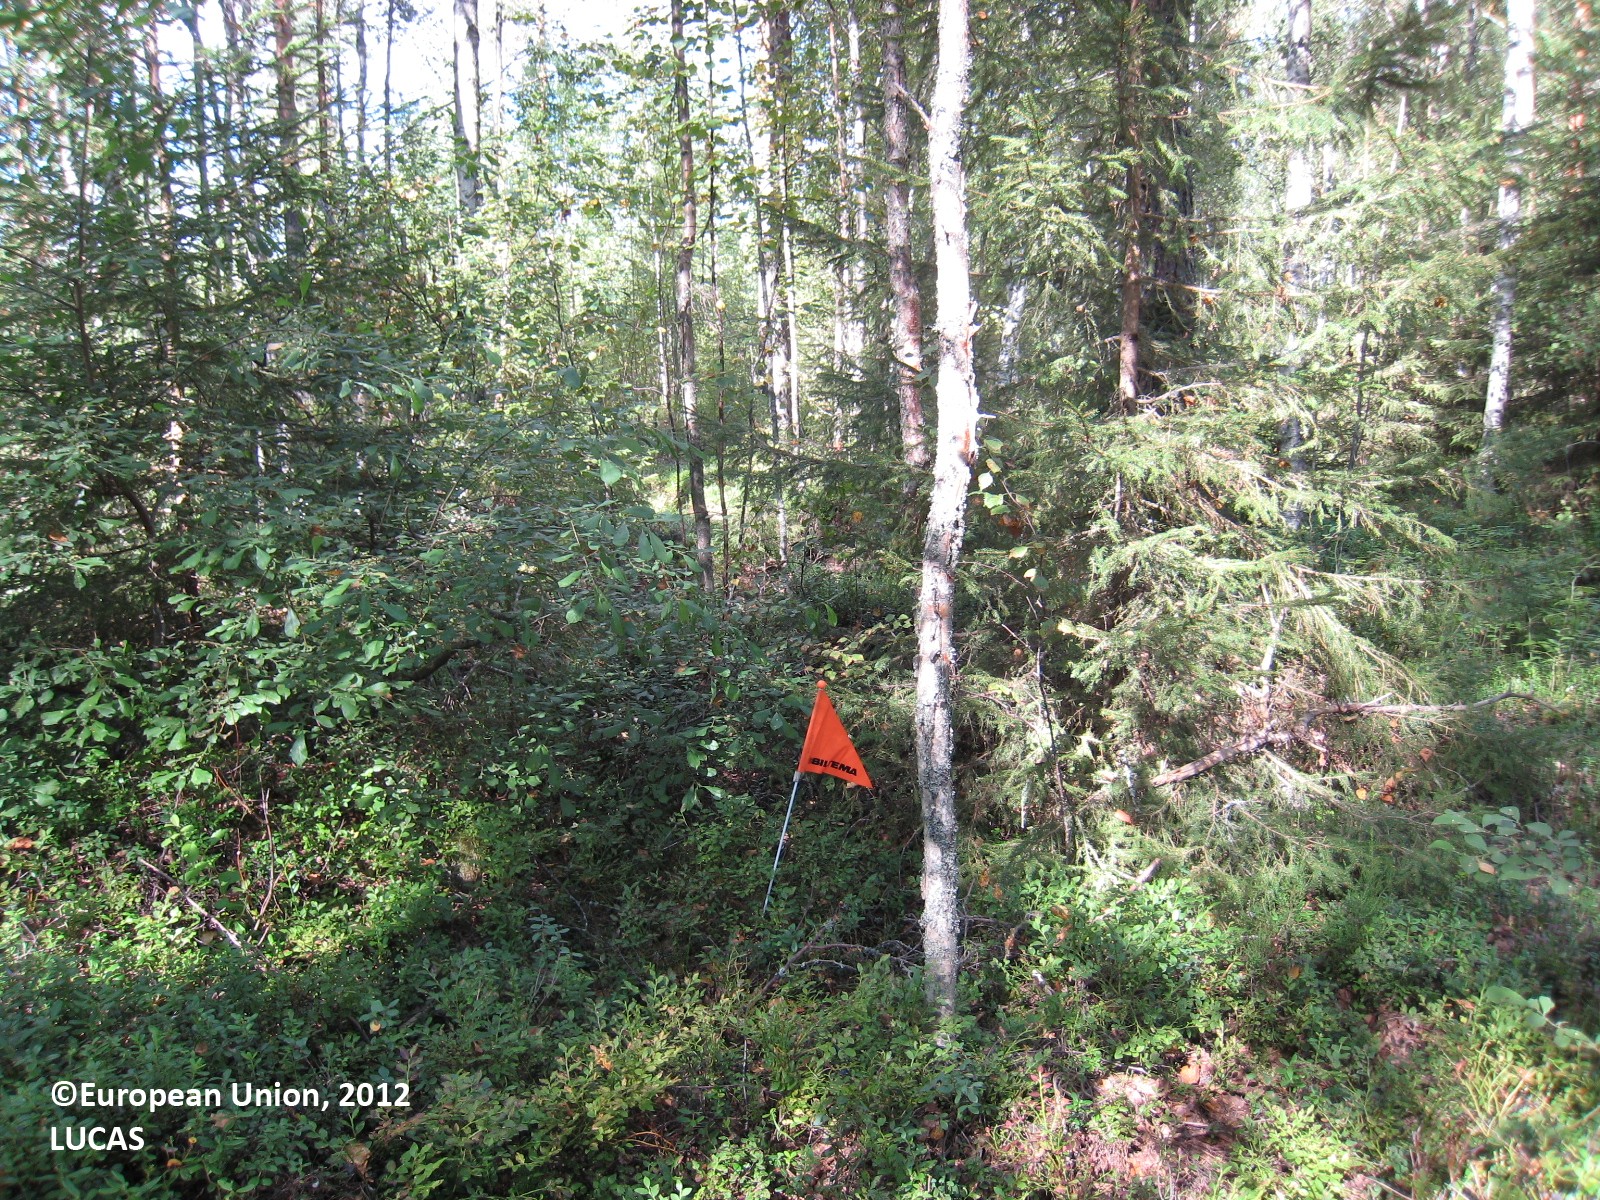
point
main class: Woodland
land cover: Pine dominated mixed woodland
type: boreal forest
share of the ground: > 75 %
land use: Forestry
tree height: > 5 m
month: August
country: FI
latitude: 61.9241
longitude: 27.3681
